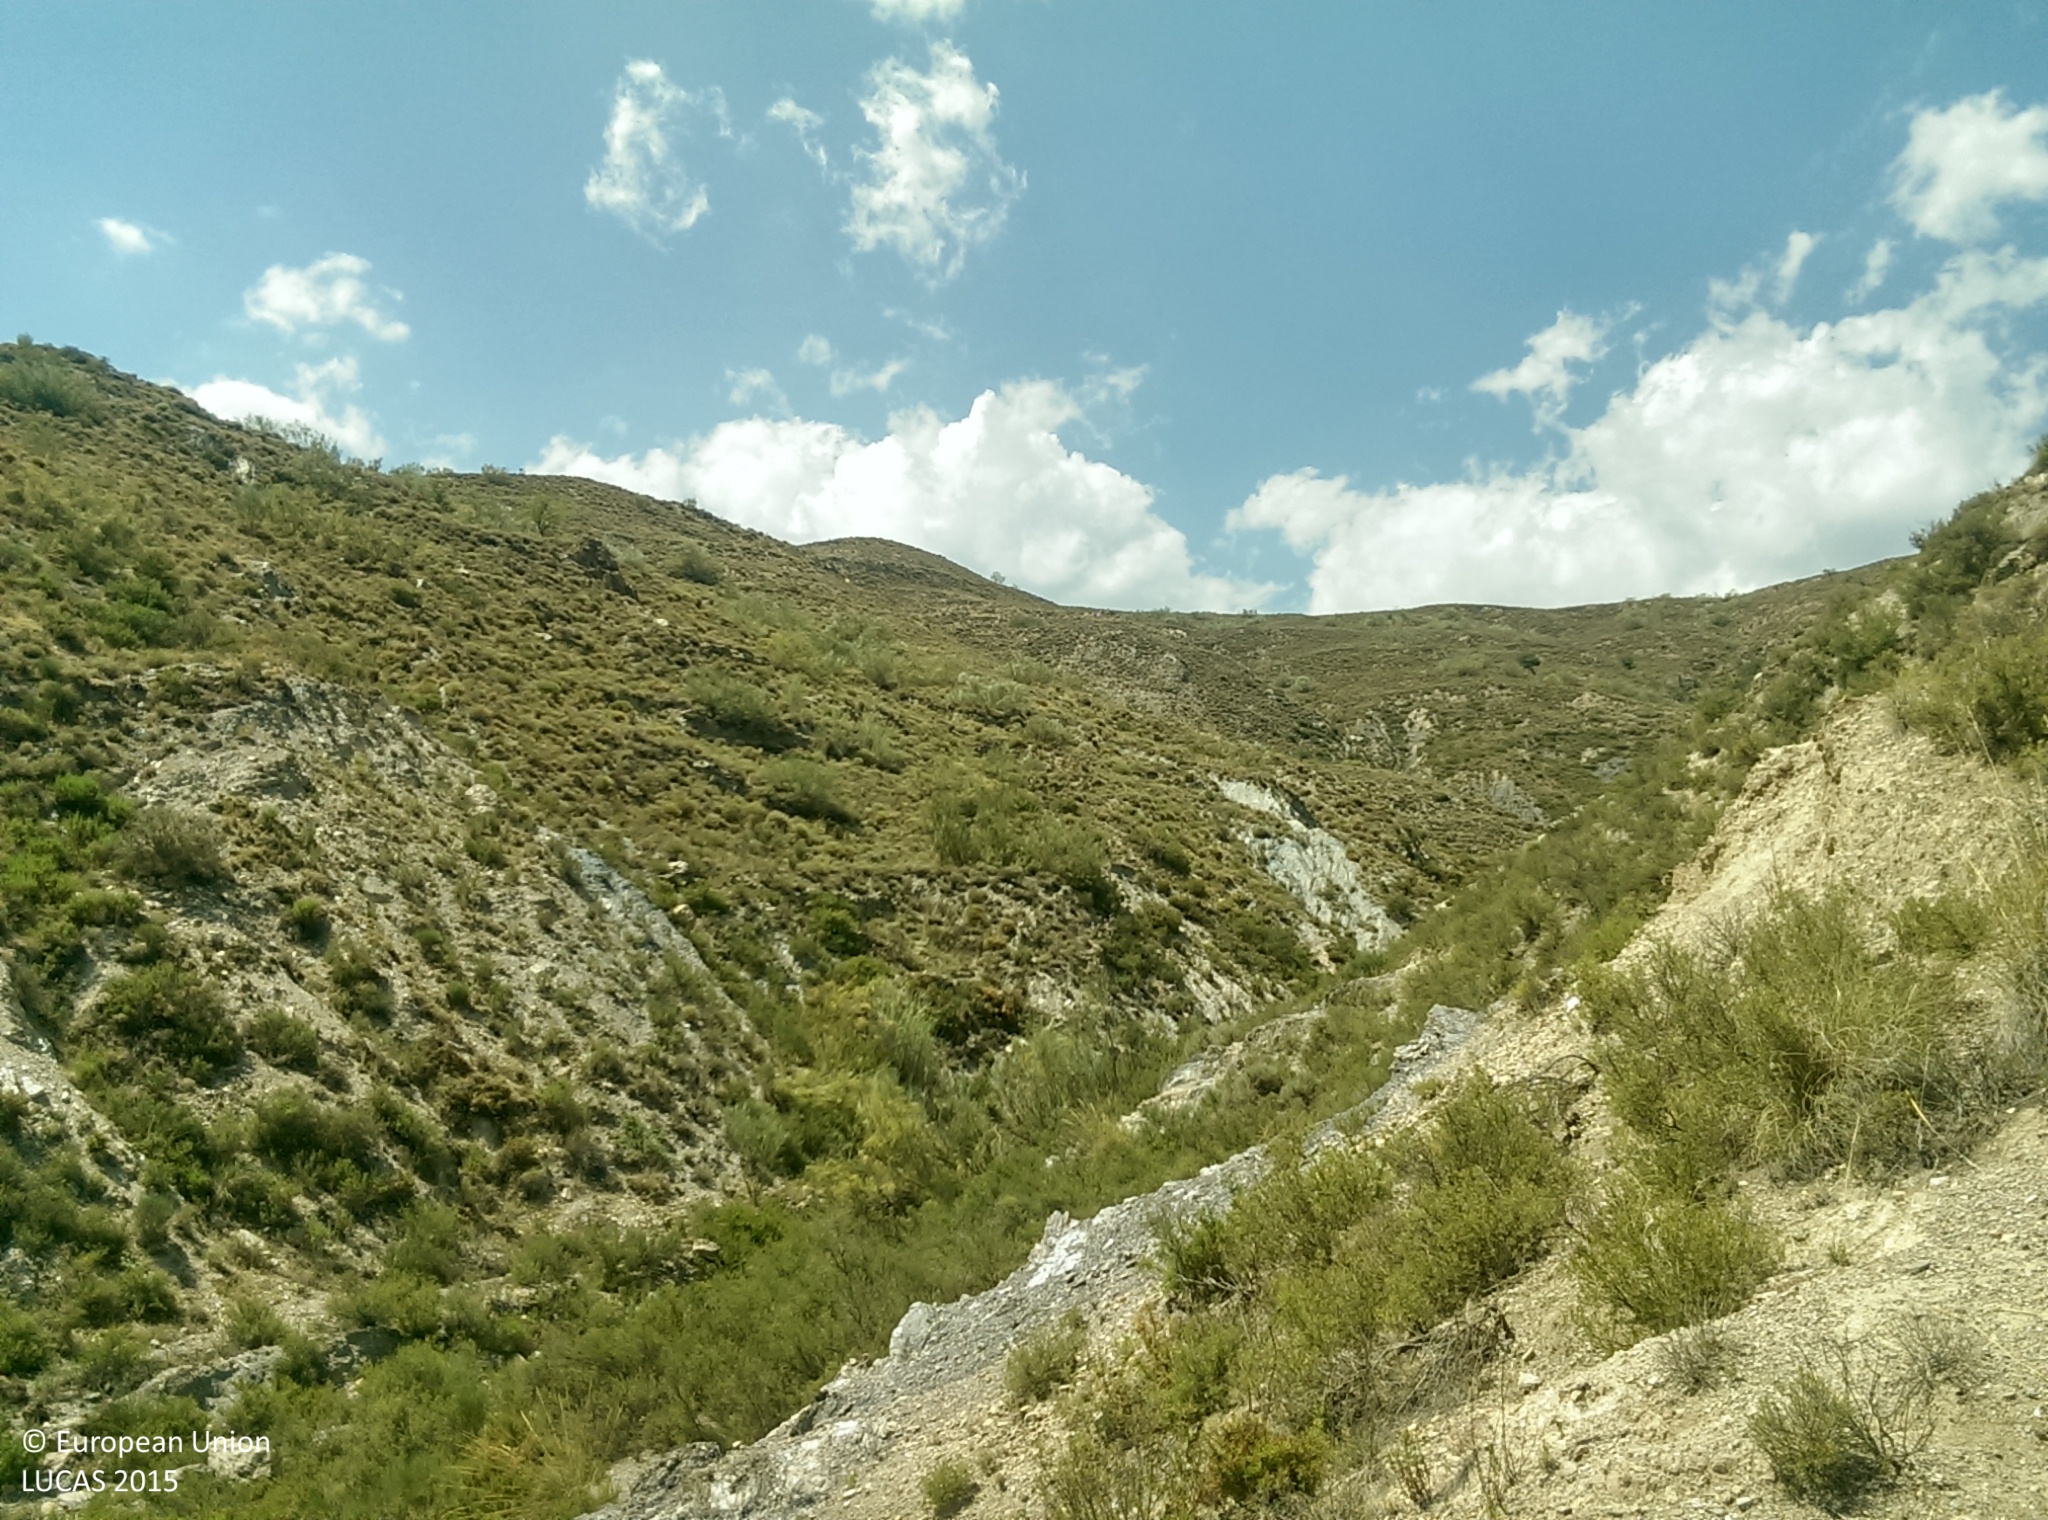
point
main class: Shrubland
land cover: Shrubland without tree cover
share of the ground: 50 - 75 %
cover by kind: shrubs 60 %, herbaceous plants 30 %, unconsolidated bare surface 10 %
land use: Semi-natural and natural areas not in use
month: July
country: ES
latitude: 36.9577
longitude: -3.1556
